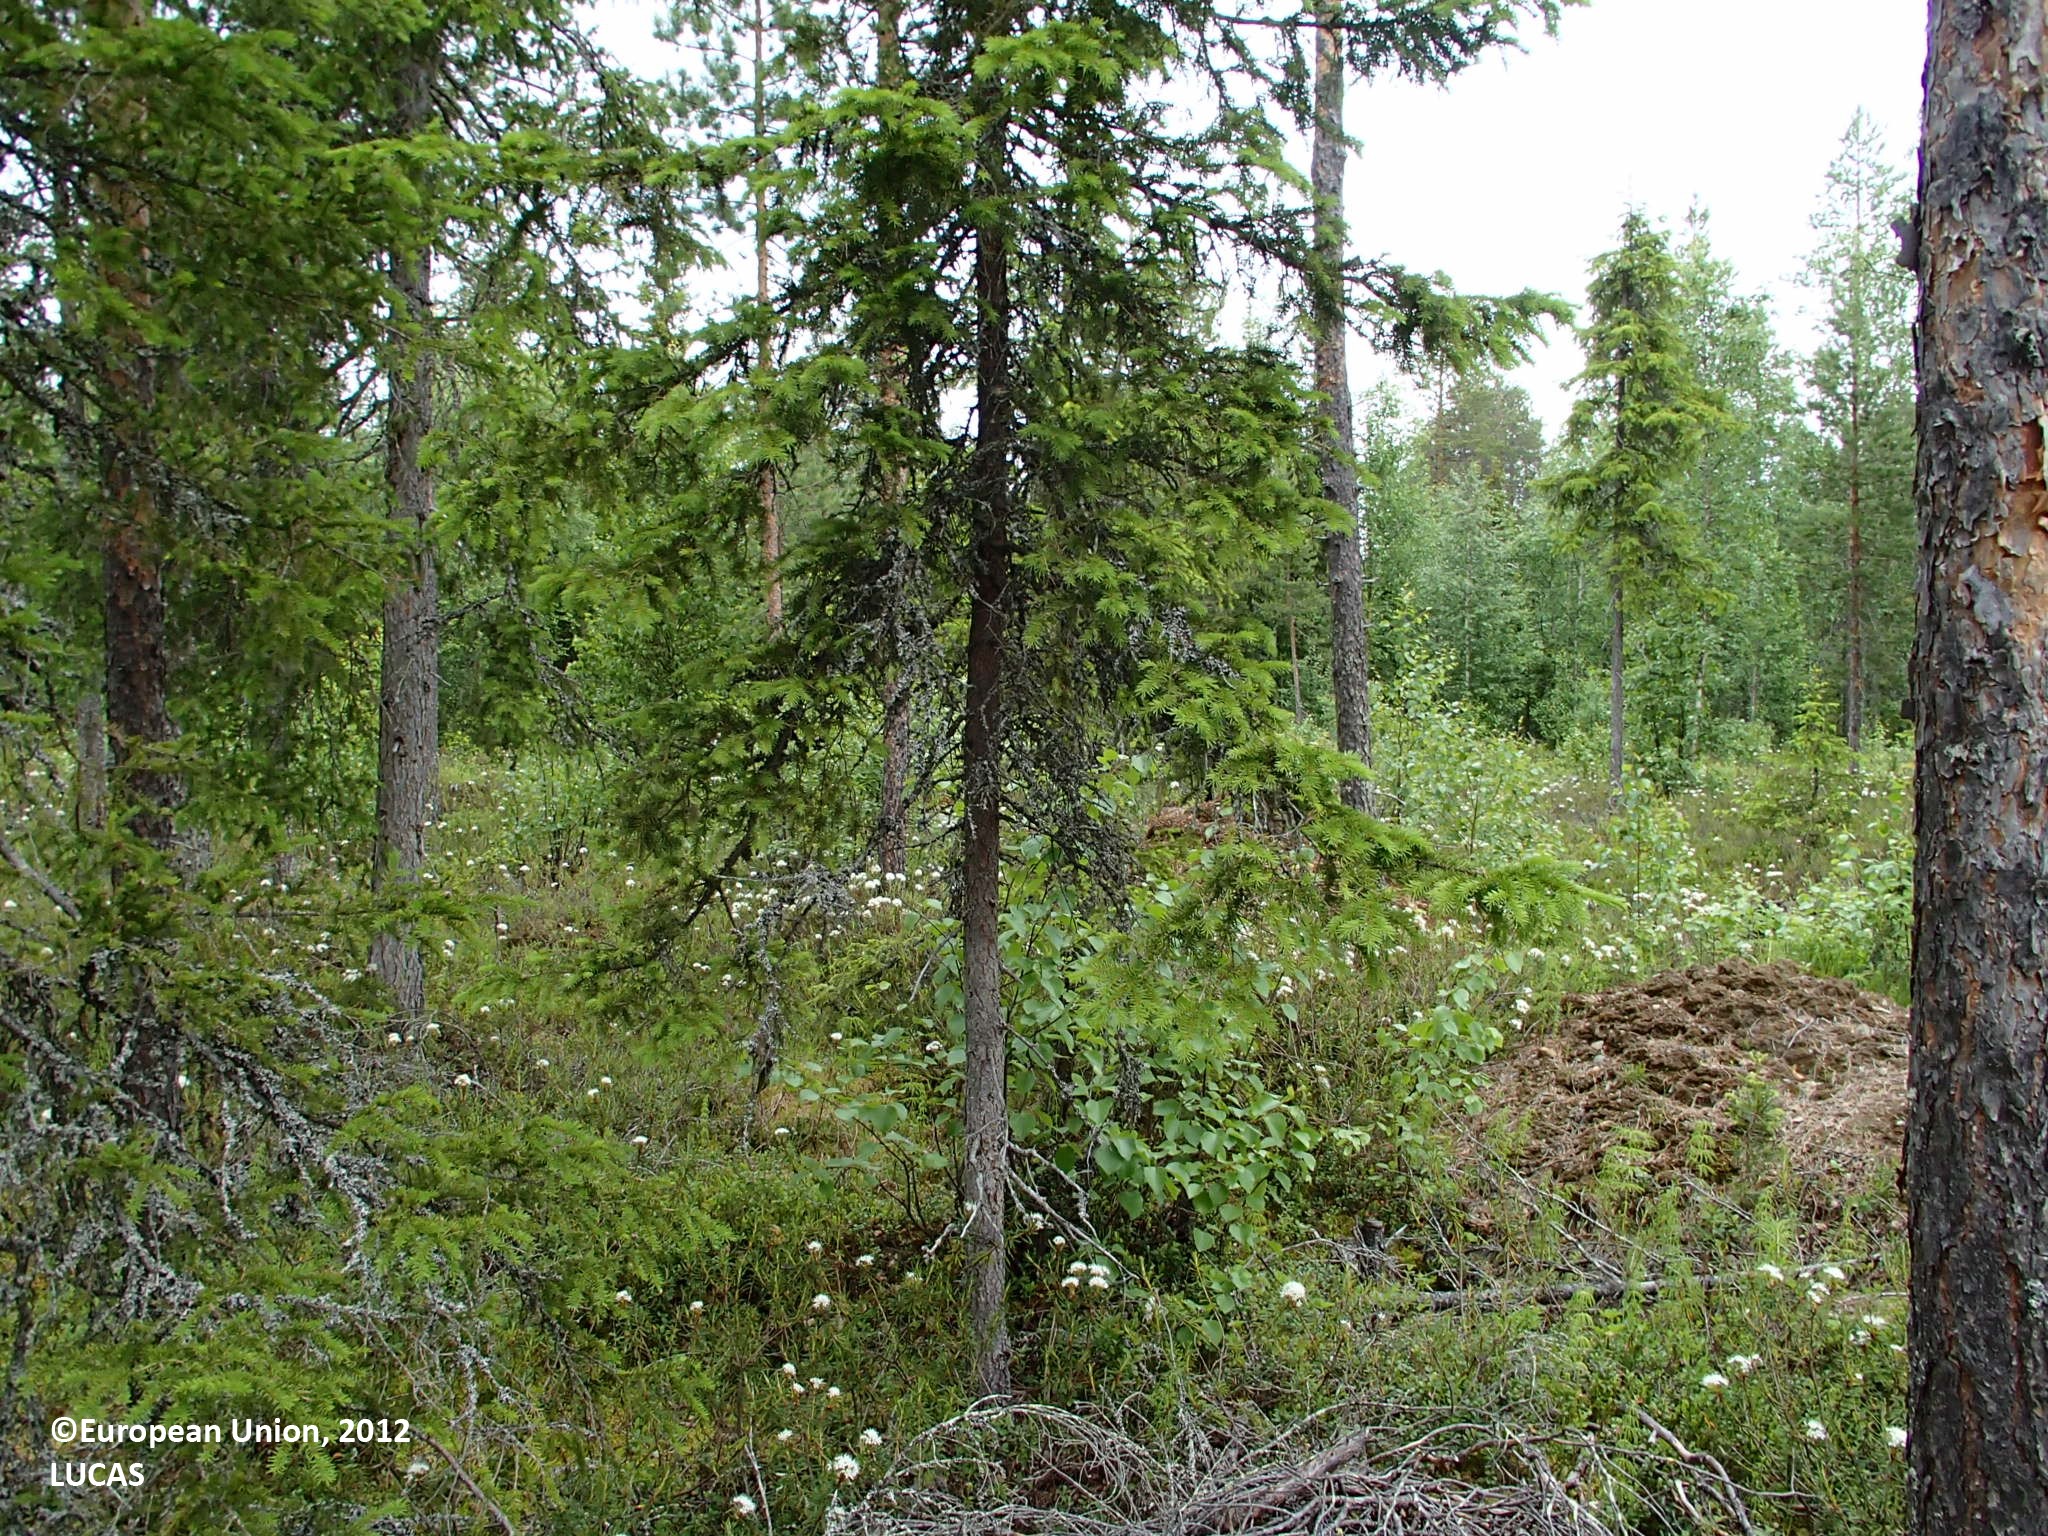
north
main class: Woodland
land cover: Other coniferous woodland
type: boreal forest
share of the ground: > 75 %
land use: Forestry
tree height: > 5 m
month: June
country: FI
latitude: 66.8740
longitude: 27.5648
